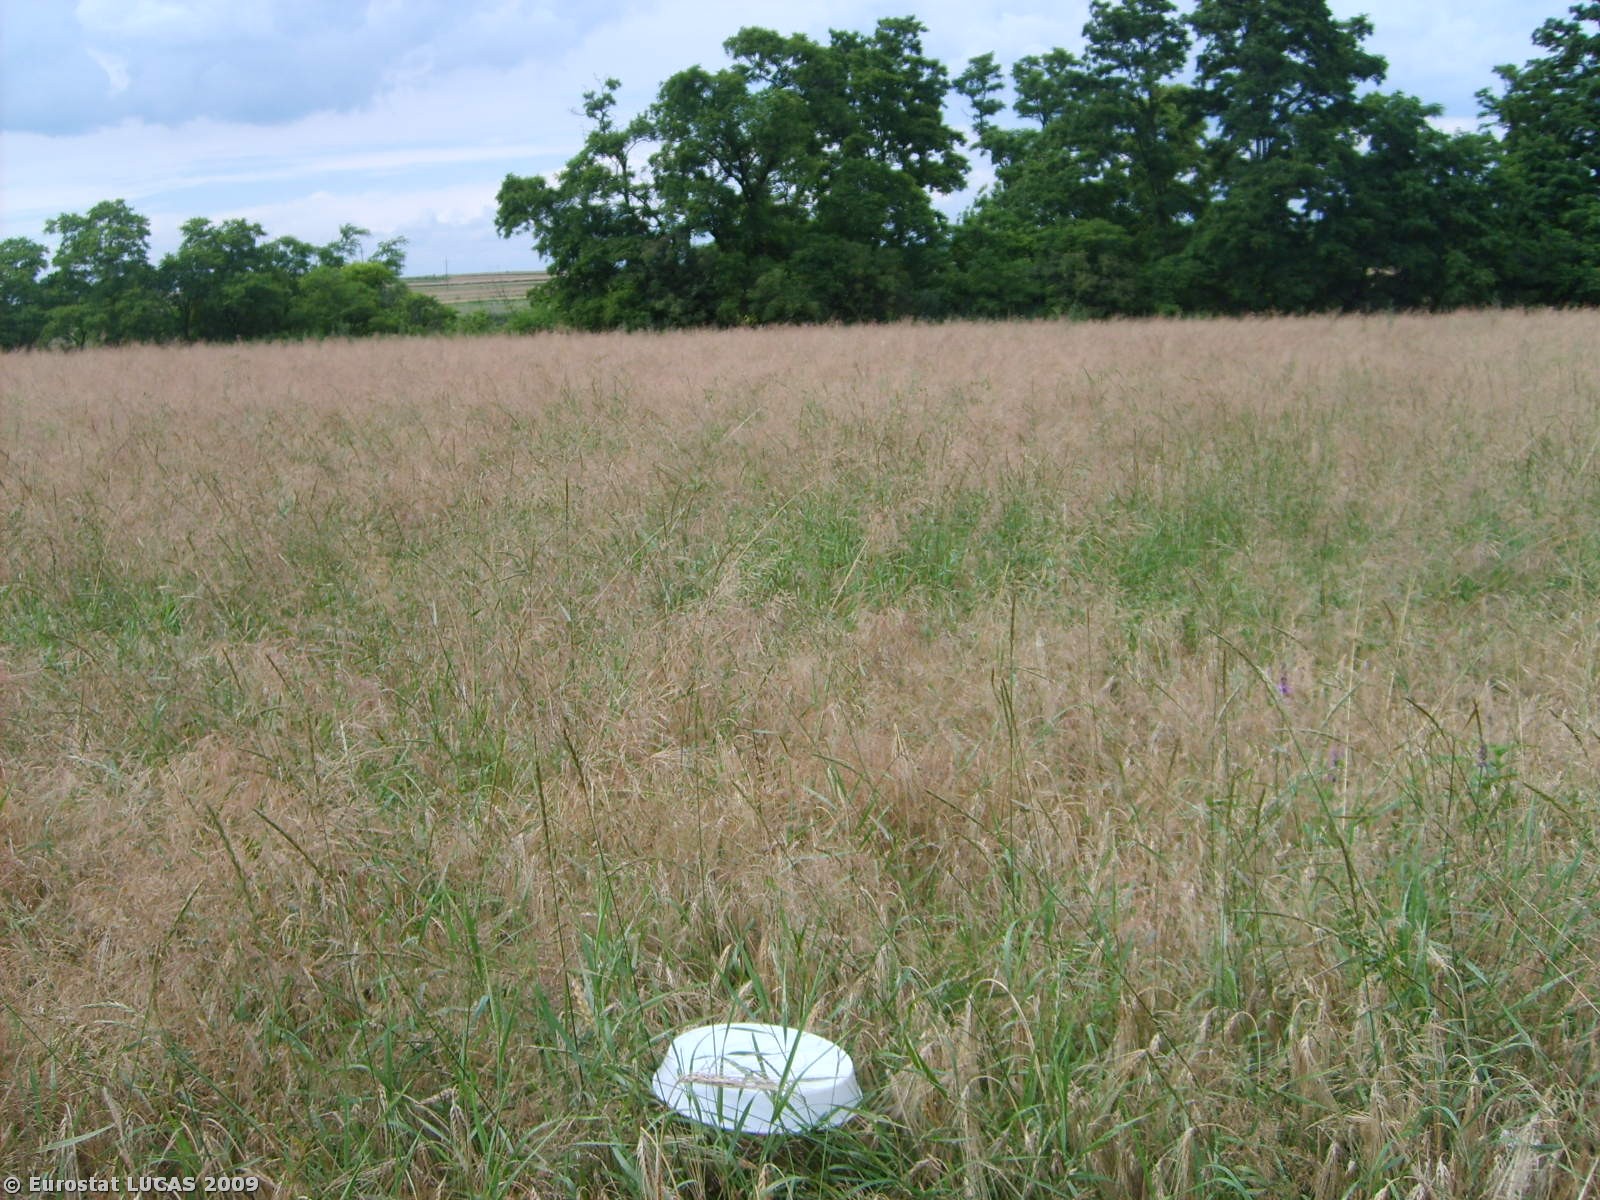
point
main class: Cropland
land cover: Barley
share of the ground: > 75 %
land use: Agriculture (excluding fallow land and kitchen gardens)
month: July
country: PL
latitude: 50.3169
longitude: 20.6711
